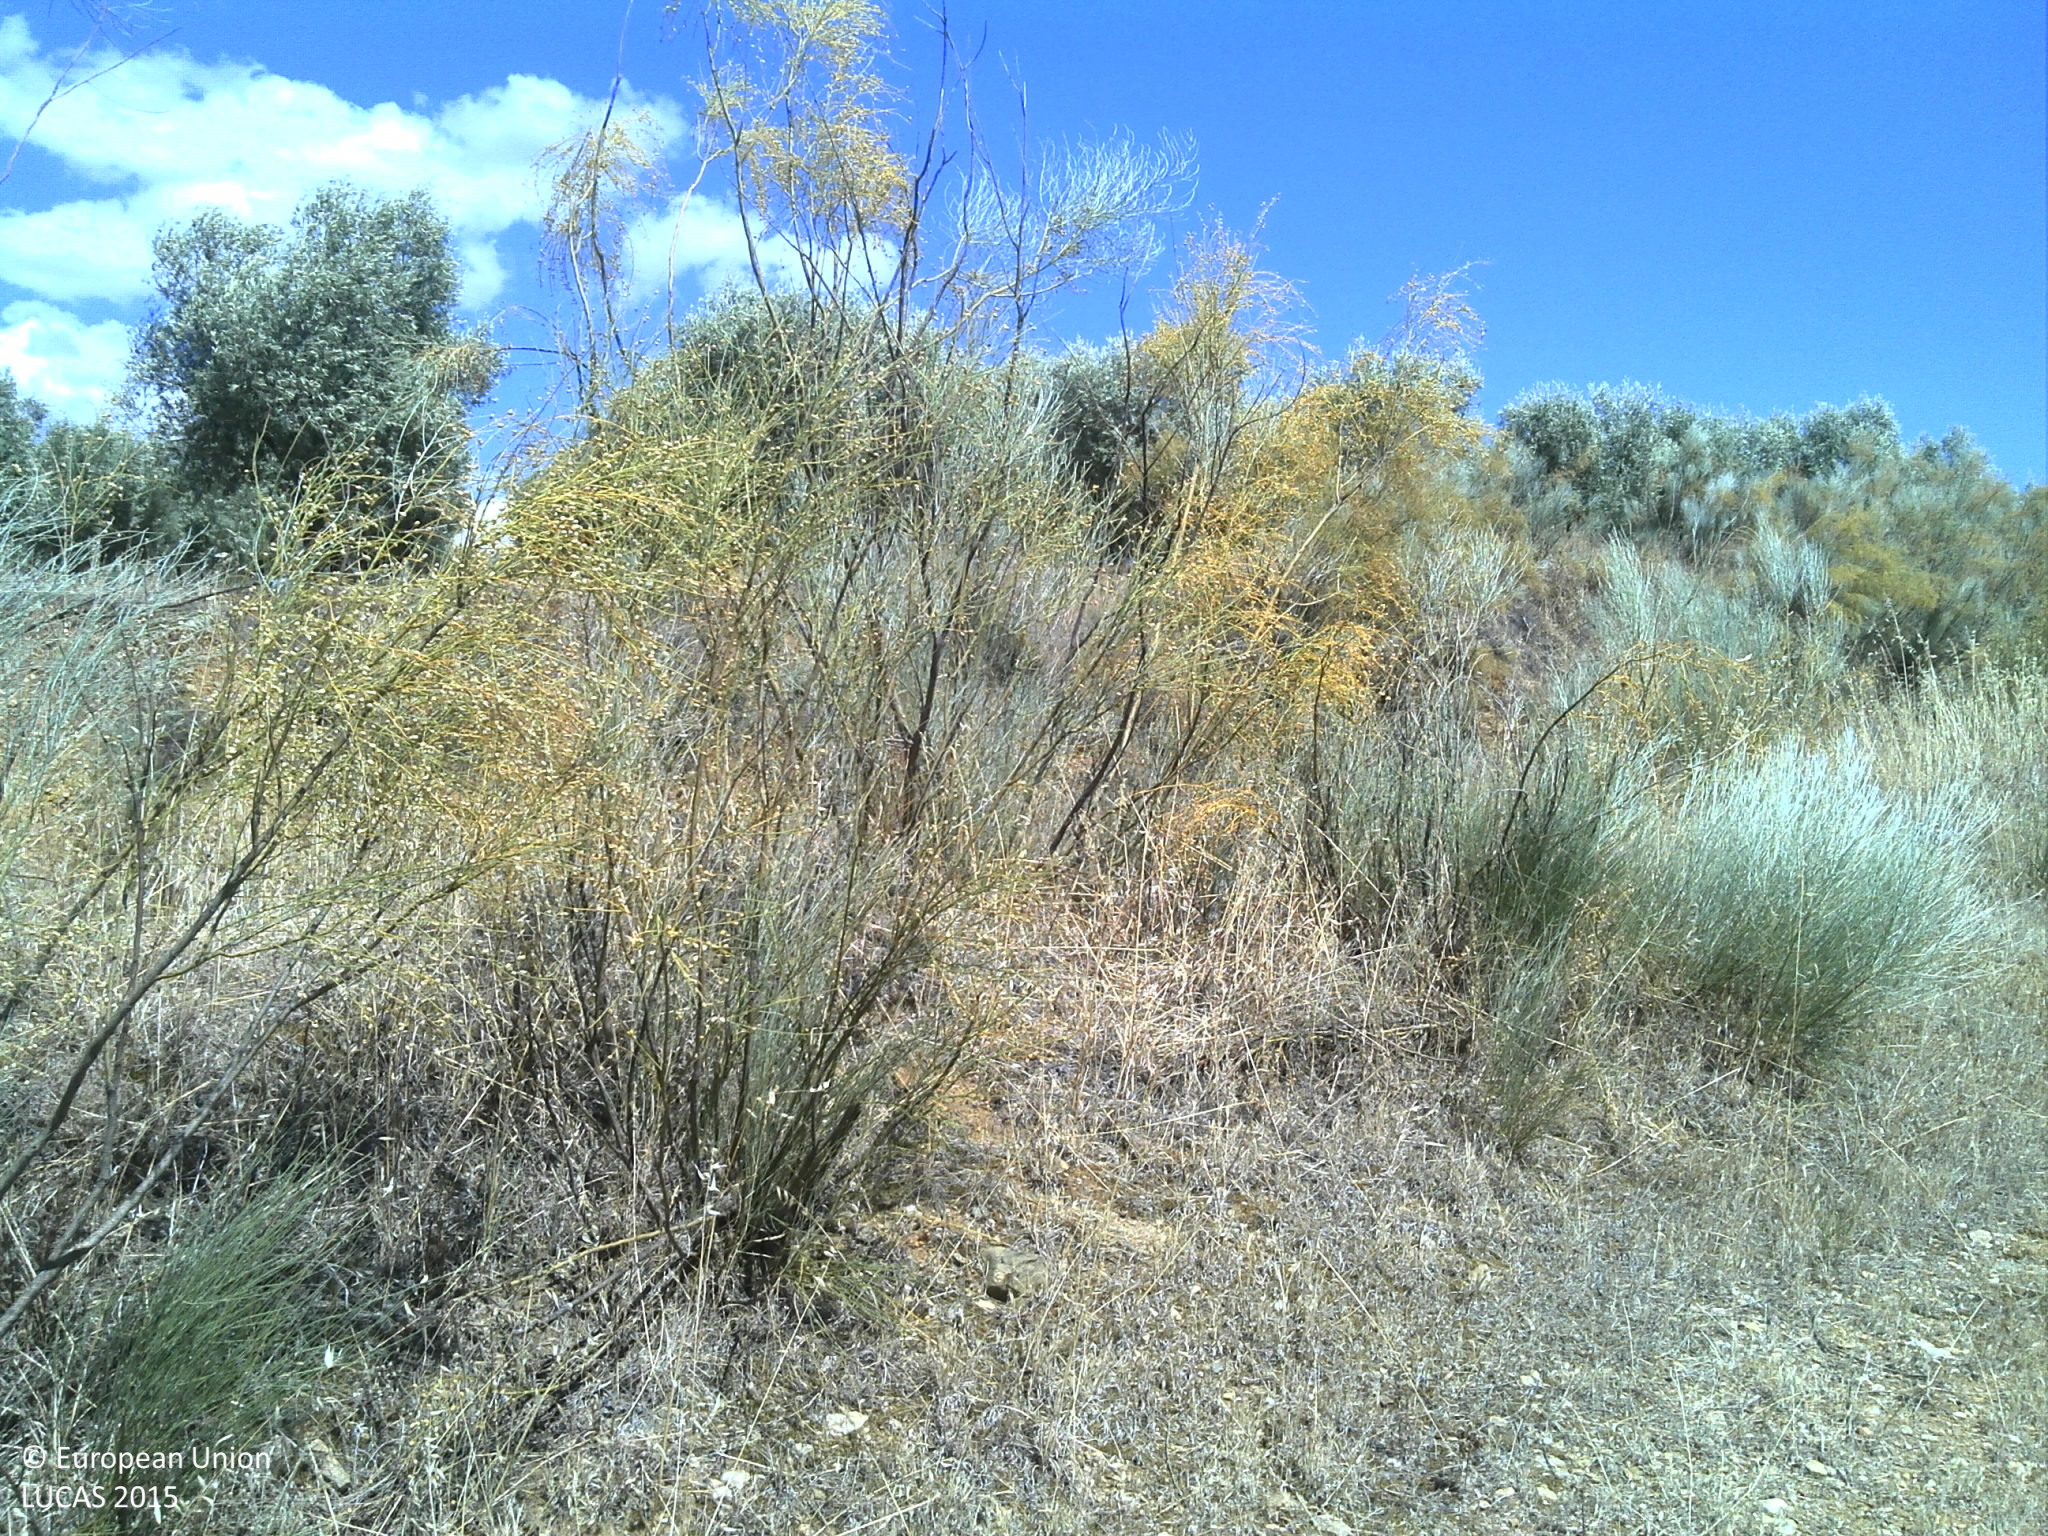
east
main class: Cropland
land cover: Vineyards
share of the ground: < 10 %
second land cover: Spontaneously vegetated surfaces
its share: 25 - 50 %
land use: Agriculture (excluding fallow land and kitchen gardens)
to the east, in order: Vineyards; Spontaneously vegetated surfaces; Vineyards; Shruby margins; Ditches and canals; Paved roads, cycling and walking lanes; Ditches and canals; Grass margins; Olive groves; Other bare soil; Vineyards; Tracks; Dry stone walls; Olive groves
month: July
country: PT
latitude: 41.3436
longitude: -7.0476
